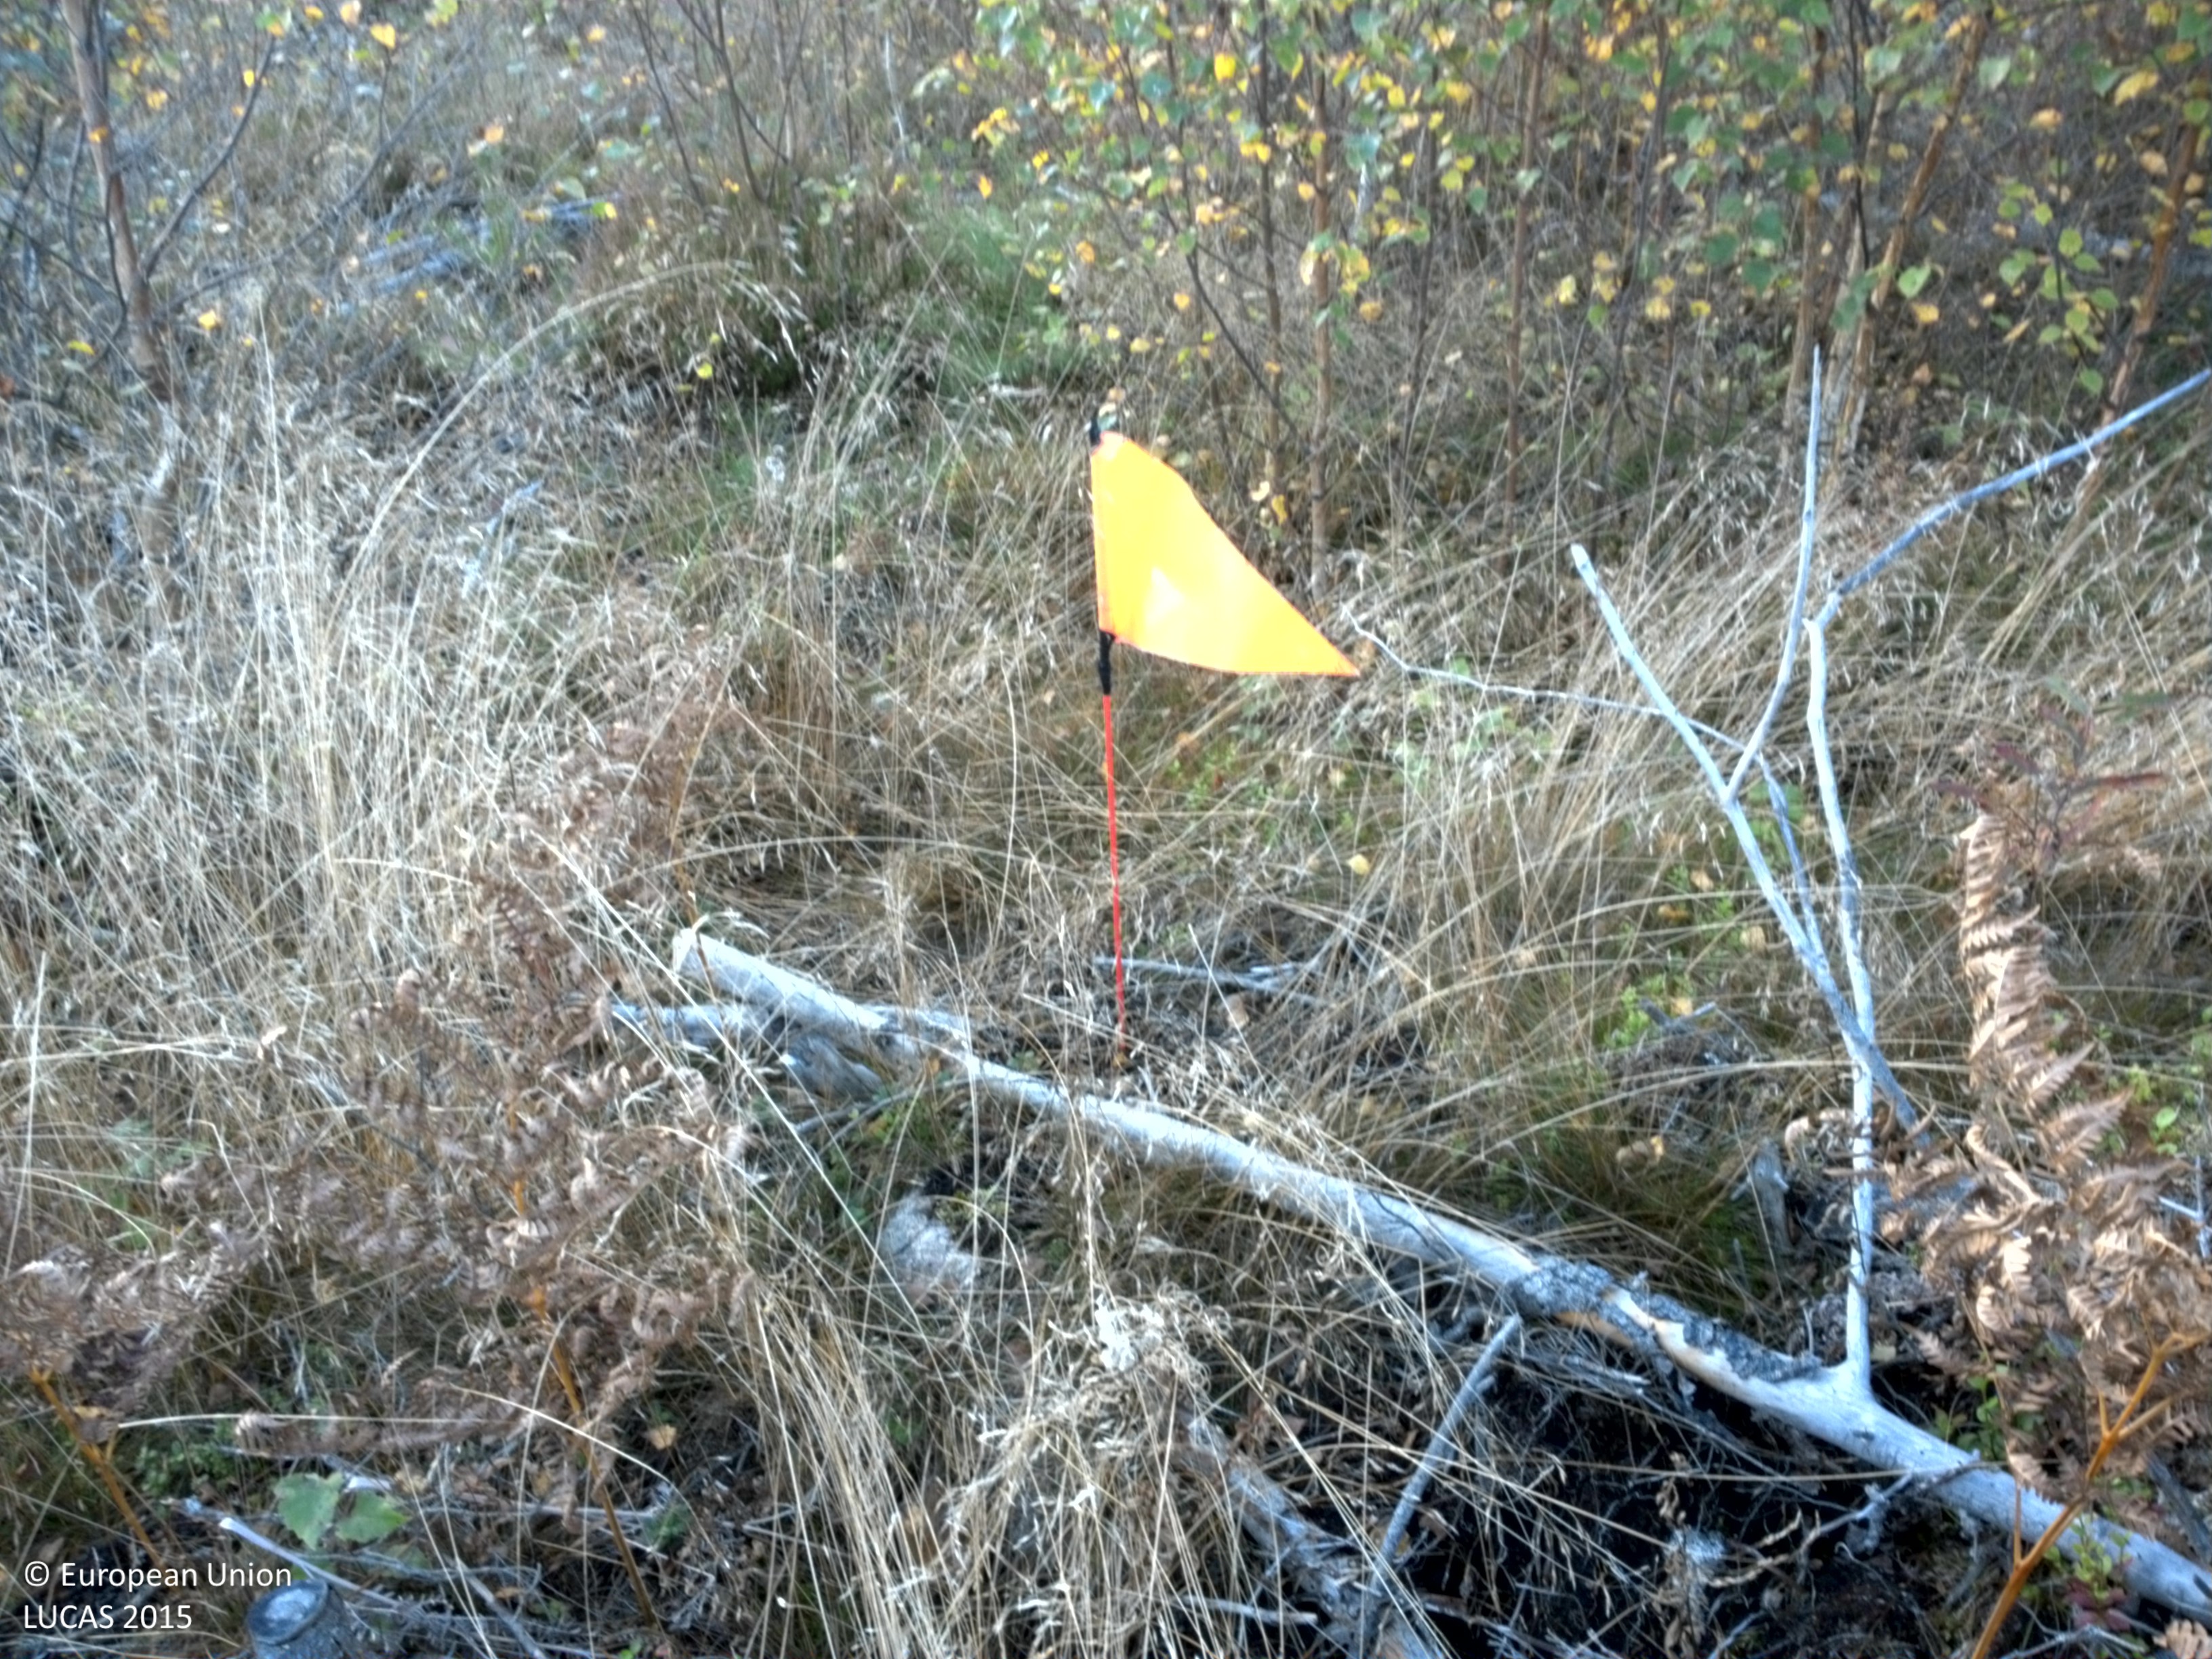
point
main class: Woodland
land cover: Broadleaved woodland
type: boreal forest
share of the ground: 25 - 50 %
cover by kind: broadleaved forest trees 45 %, herbaceous plants 40 %, unconsolidated bare surface 10 %, coniferous forest trees 5 %
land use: Forestry
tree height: < 5 m
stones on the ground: < 10 %
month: September
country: SE
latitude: 59.9736
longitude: 16.5659
